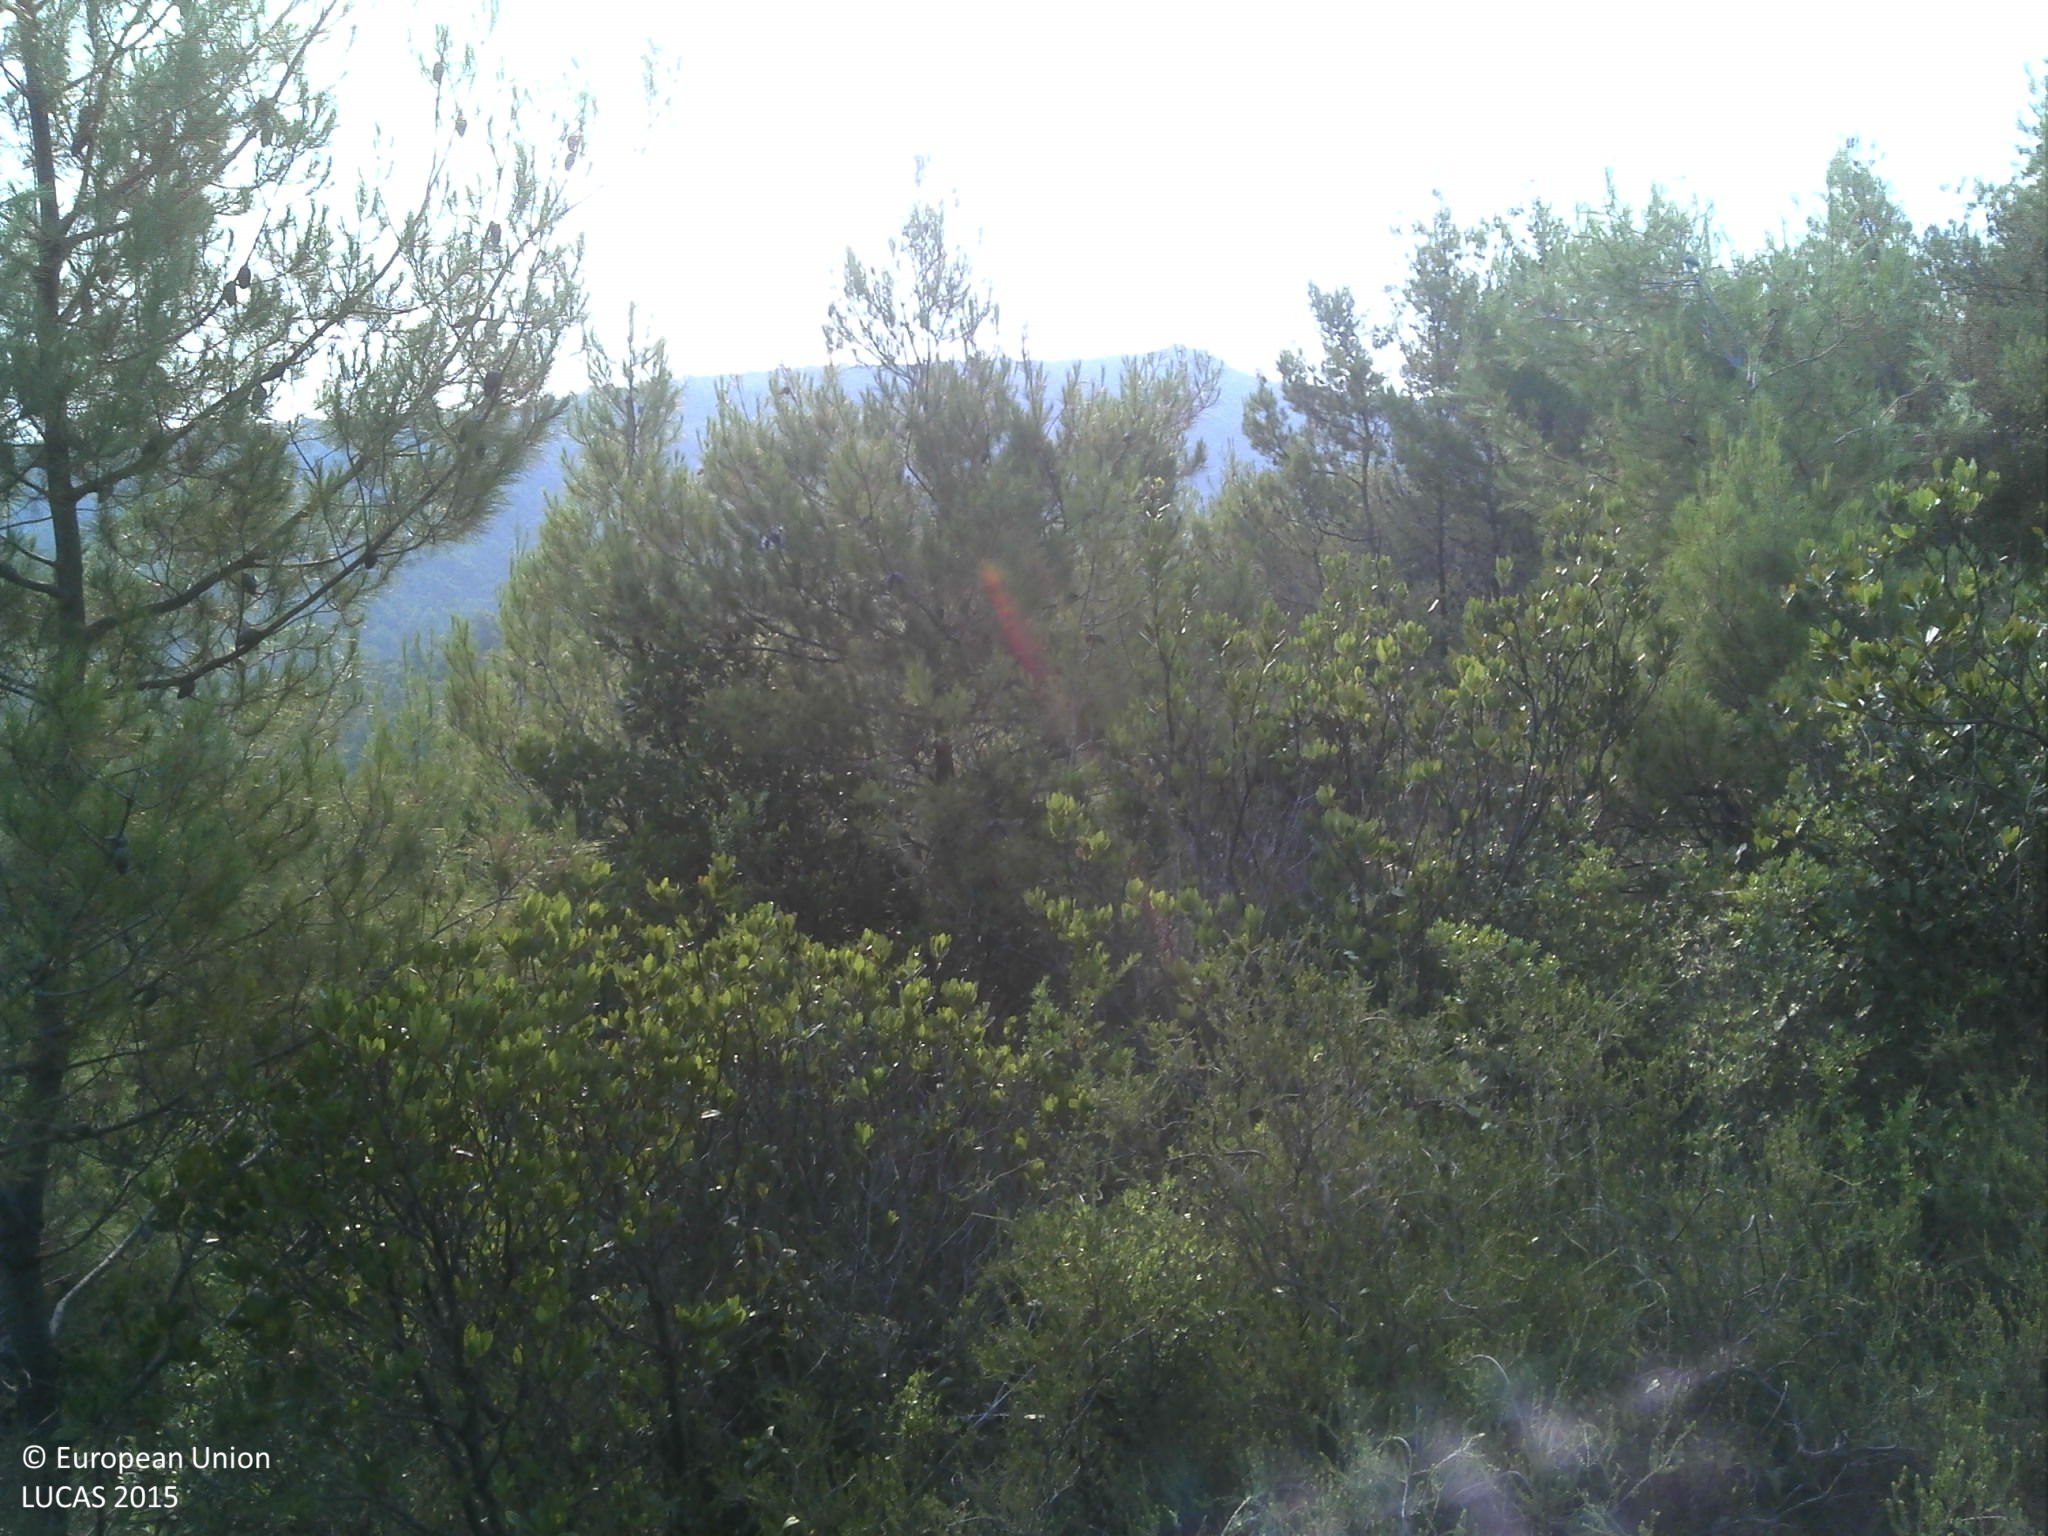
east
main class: Woodland
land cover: Pine dominated coniferous woodland
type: coniferous forest of the mediterranean region
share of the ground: > 75 %
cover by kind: coniferous forest trees 60 %, shrubs 20 %, consolidated bare surface 10 %, unconsolidated bare surface 10 %
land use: Semi-natural and natural areas not in use
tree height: > 5 m
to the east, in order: Pine dominated coniferous woodland
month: July
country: HR
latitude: 42.8134
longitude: 17.7070
